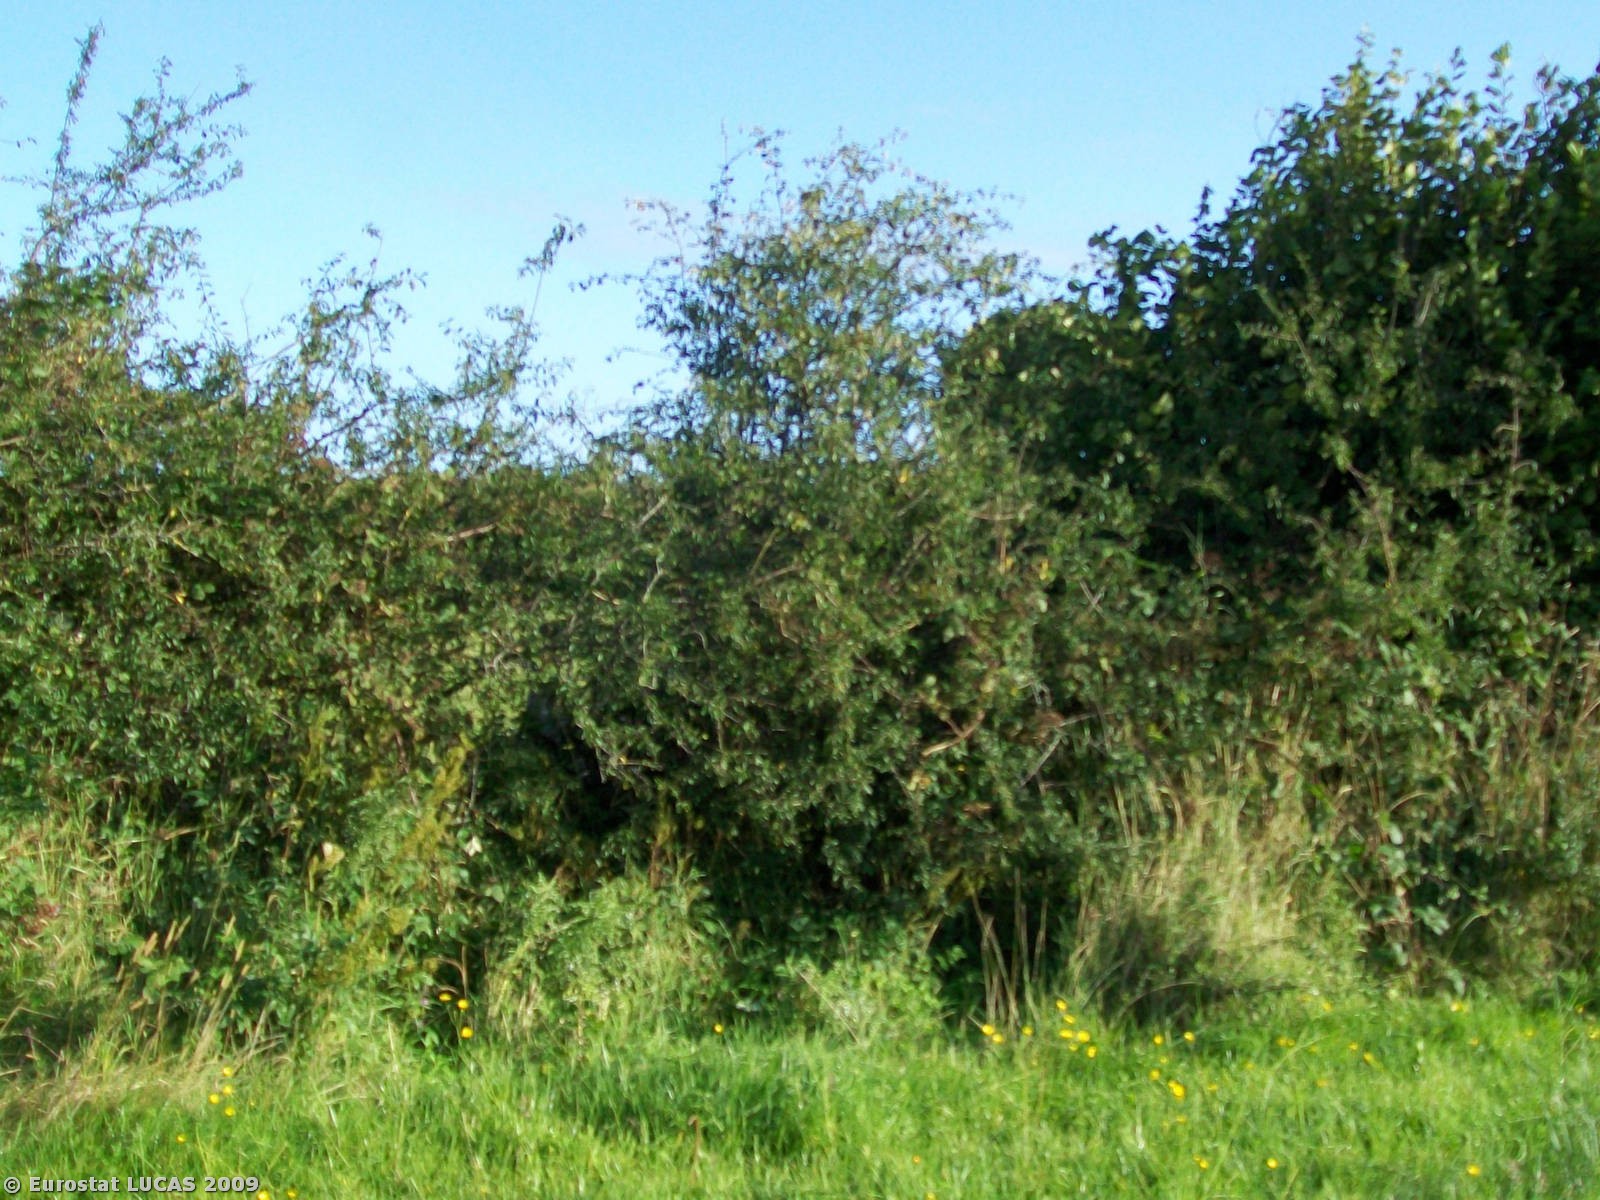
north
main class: Grassland
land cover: Grassland without tree/shrub cover
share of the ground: > 75 %
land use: Agriculture (excluding fallow land and kitchen gardens)
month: August
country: IE
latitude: 53.2283
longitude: -8.7635
